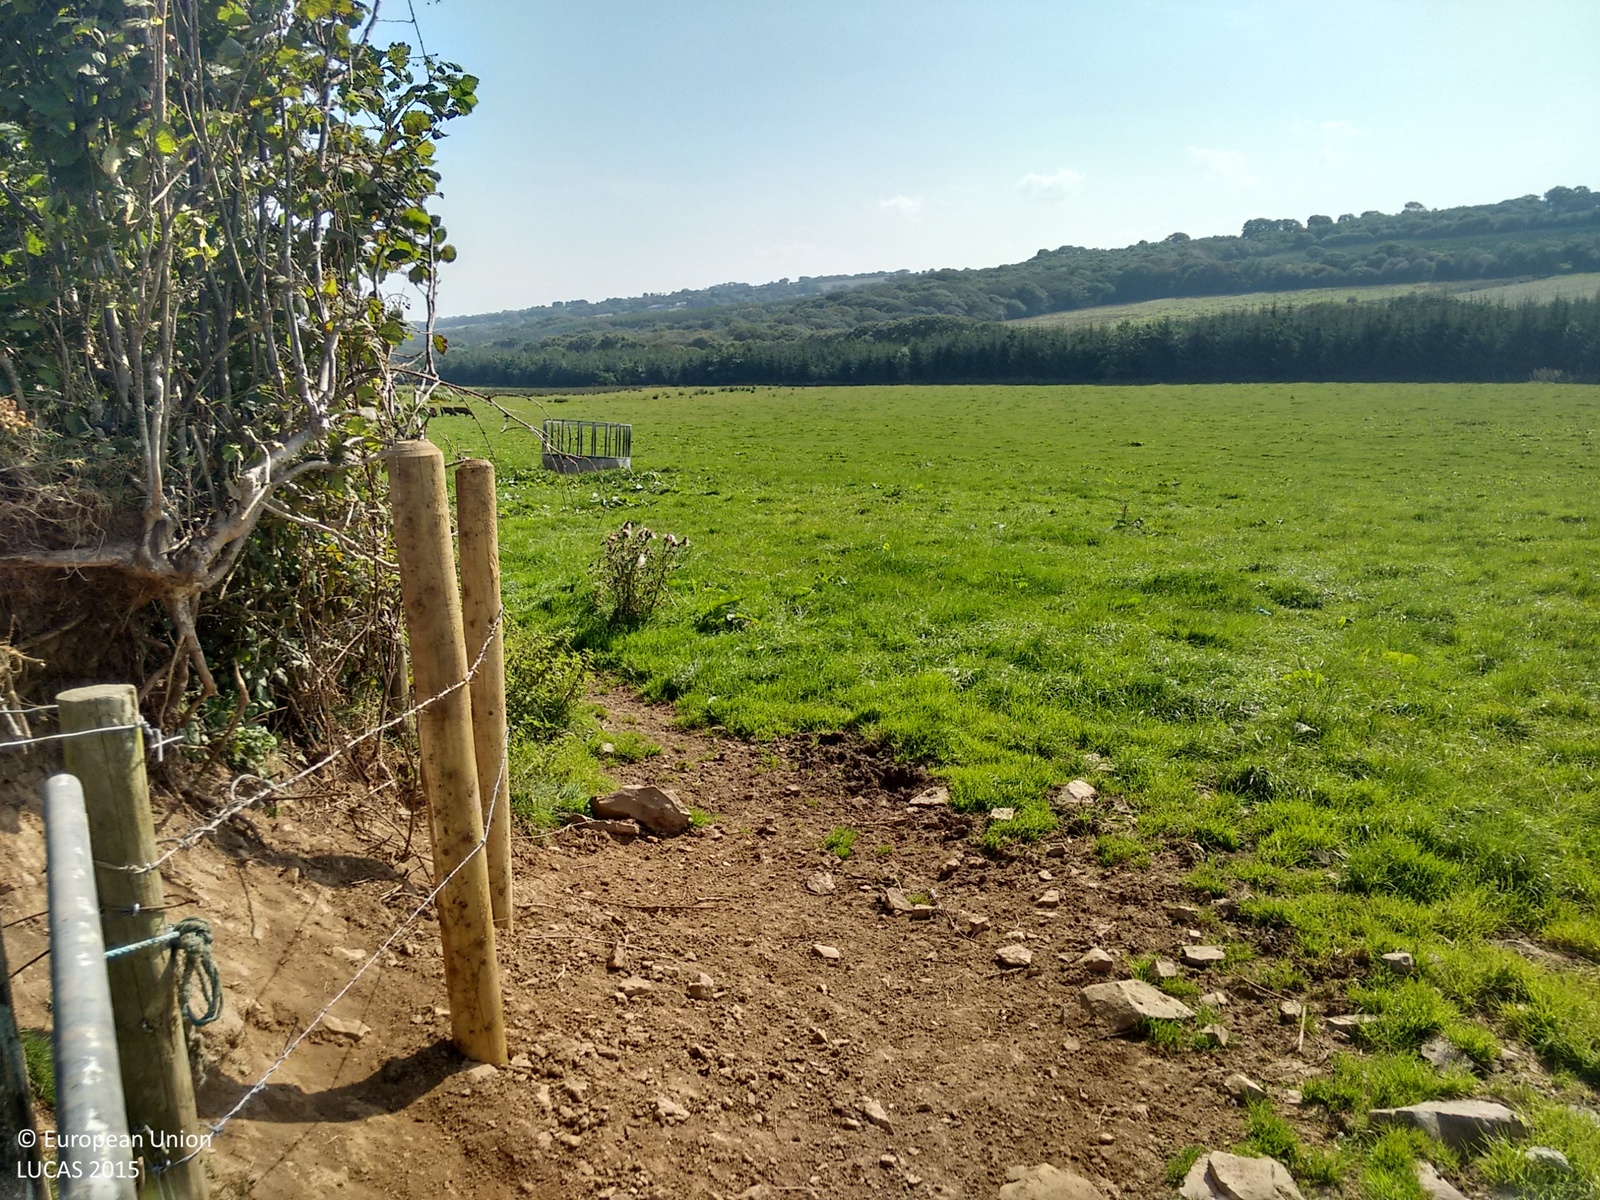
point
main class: Grassland
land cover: Grassland without tree/shrub cover
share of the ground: > 75 %
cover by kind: herbaceous plants 100 %
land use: Agriculture (excluding fallow land and kitchen gardens)
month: September
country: GB
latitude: 50.8281
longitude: -4.3121
